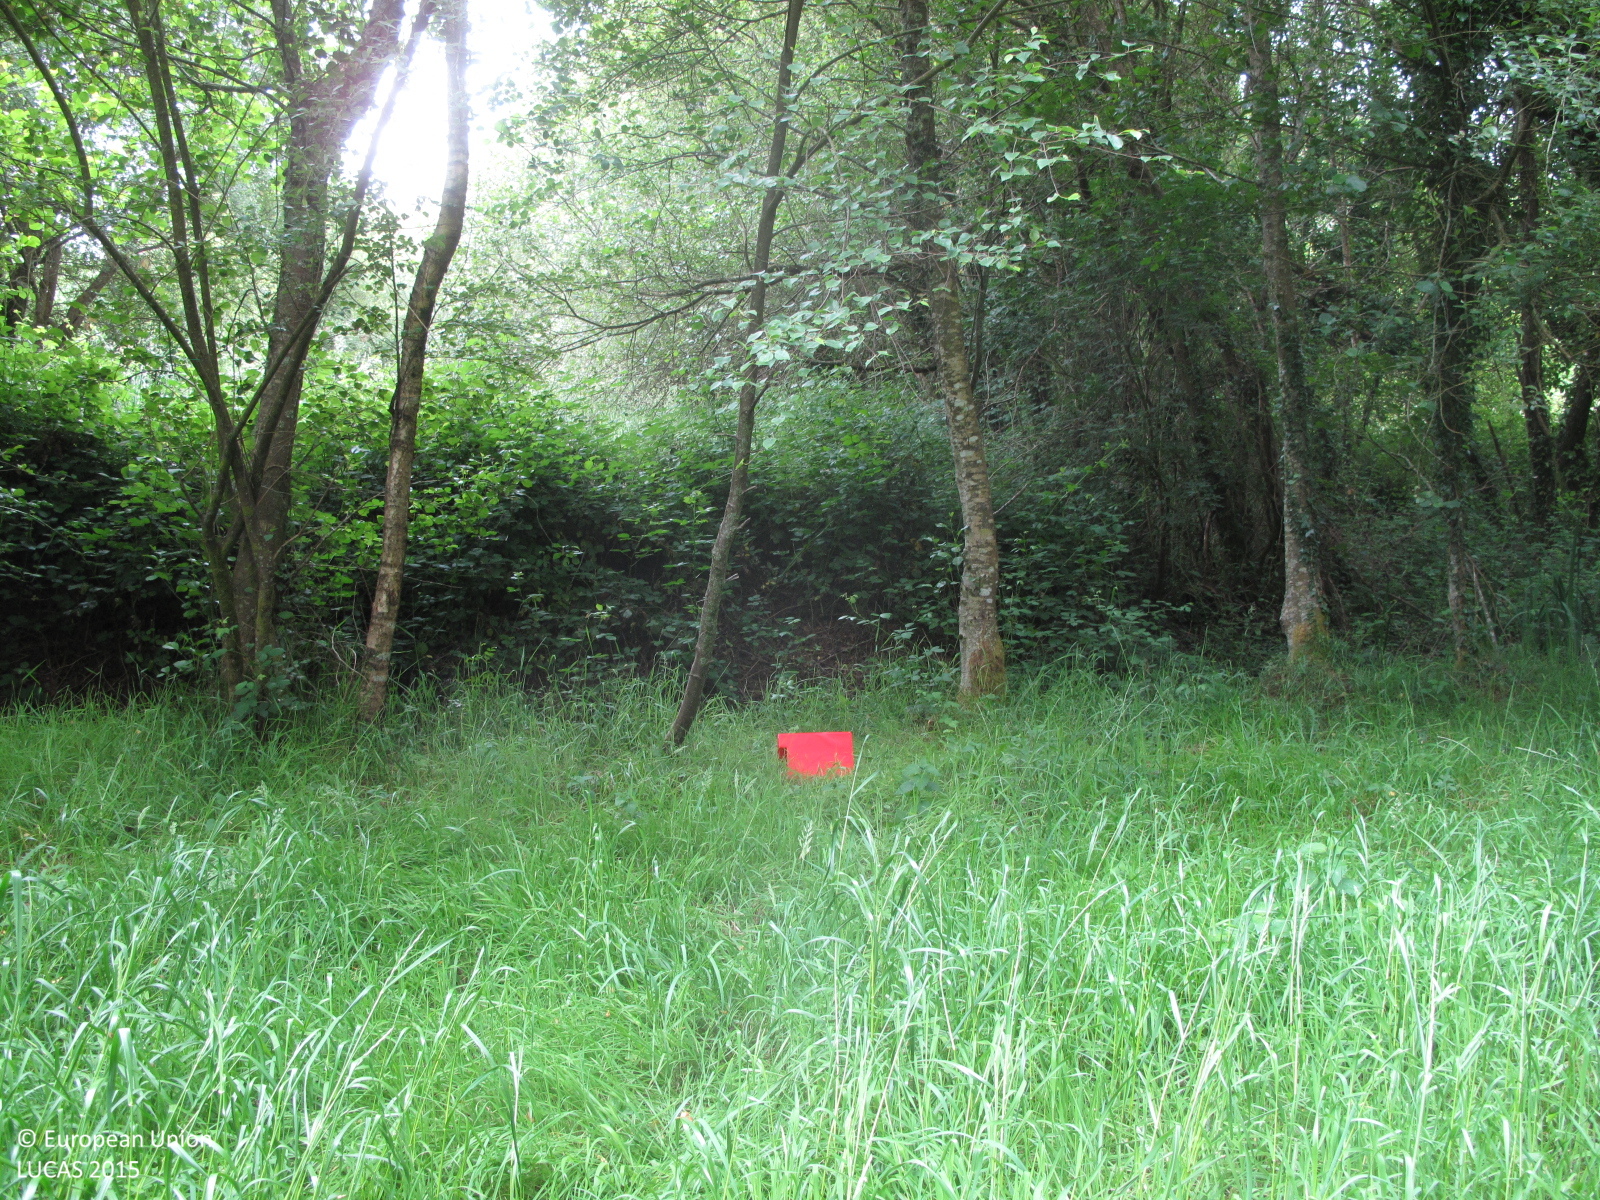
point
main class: Woodland
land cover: Broadleaved woodland
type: acidophilous oak and oak-birch forest
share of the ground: > 75 %
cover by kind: broadleaved forest trees 90 %, shrubs 5 %, herbaceous plants 5 %
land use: Semi-natural and natural areas not in use
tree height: > 5 m
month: June
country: ES
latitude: 43.1378
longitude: -8.5625
